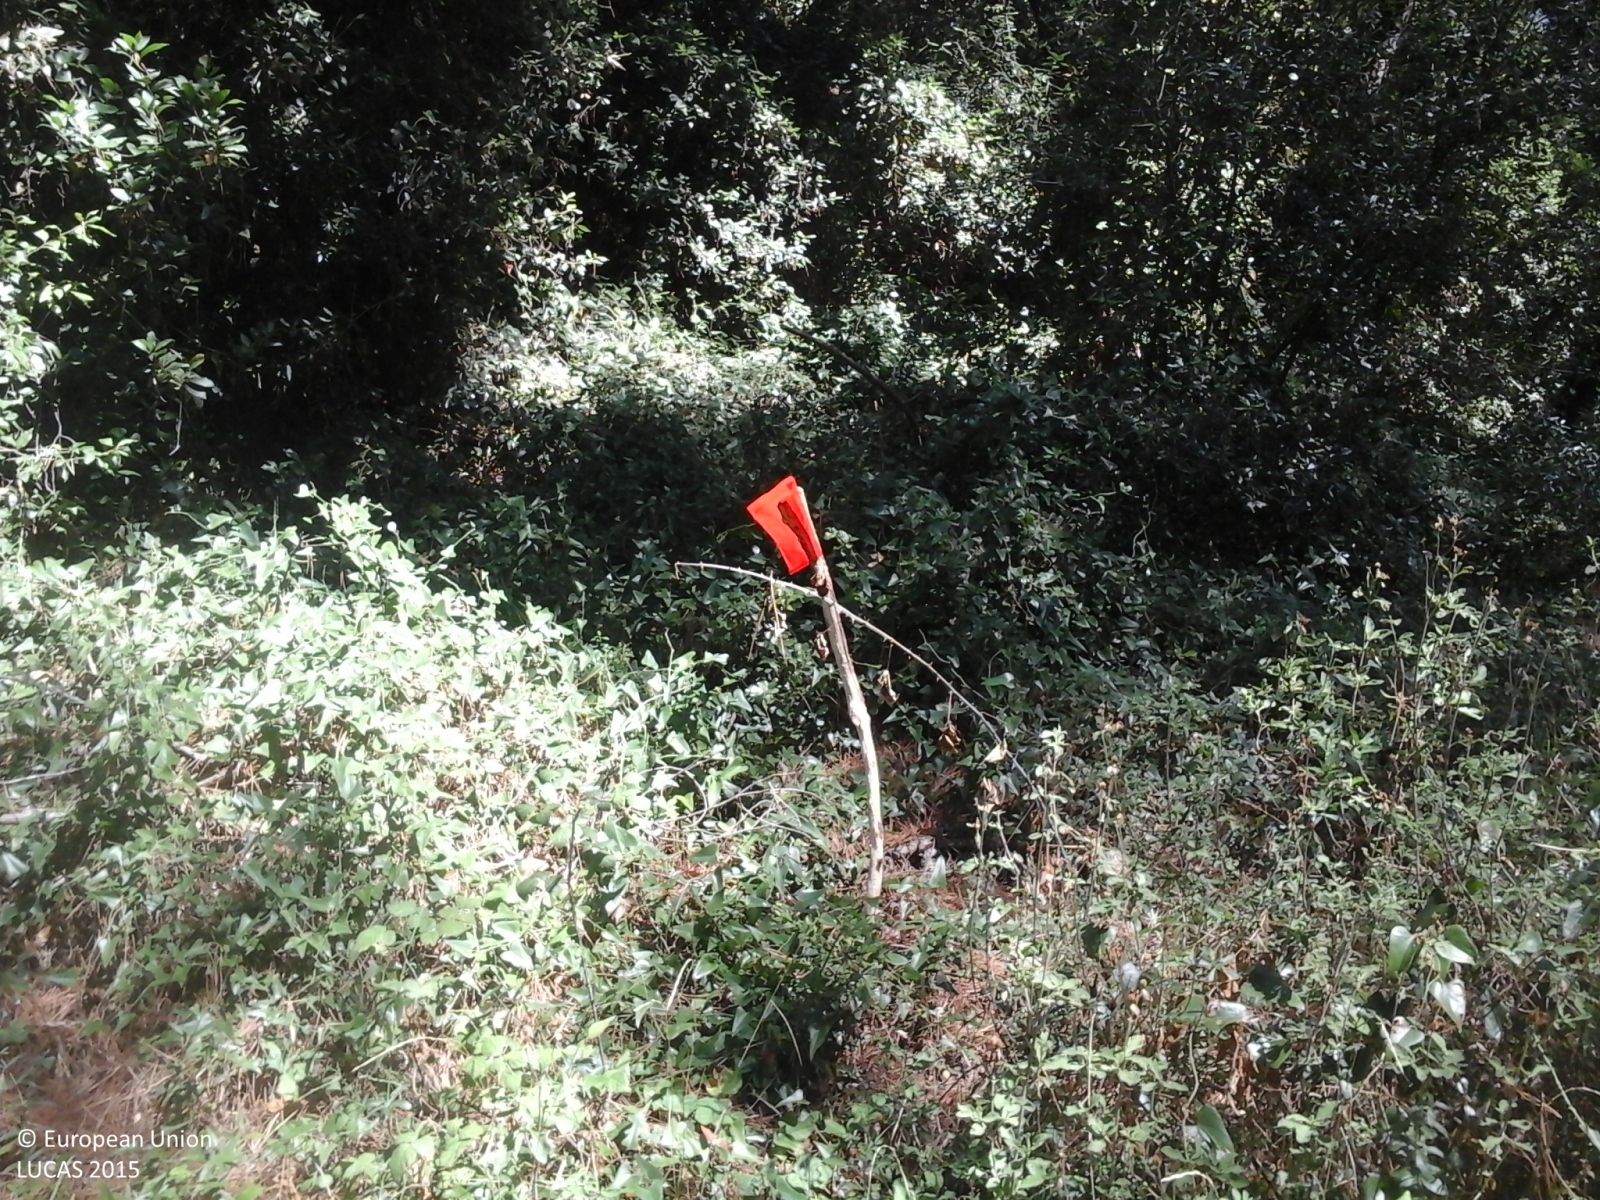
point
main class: Woodland
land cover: Pine dominated coniferous woodland
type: coniferous forest of the mediterranean region
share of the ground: > 75 %
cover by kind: coniferous forest trees 100 %
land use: Forestry
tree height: > 5 m
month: August
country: IT
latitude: 43.6646
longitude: 10.2844
